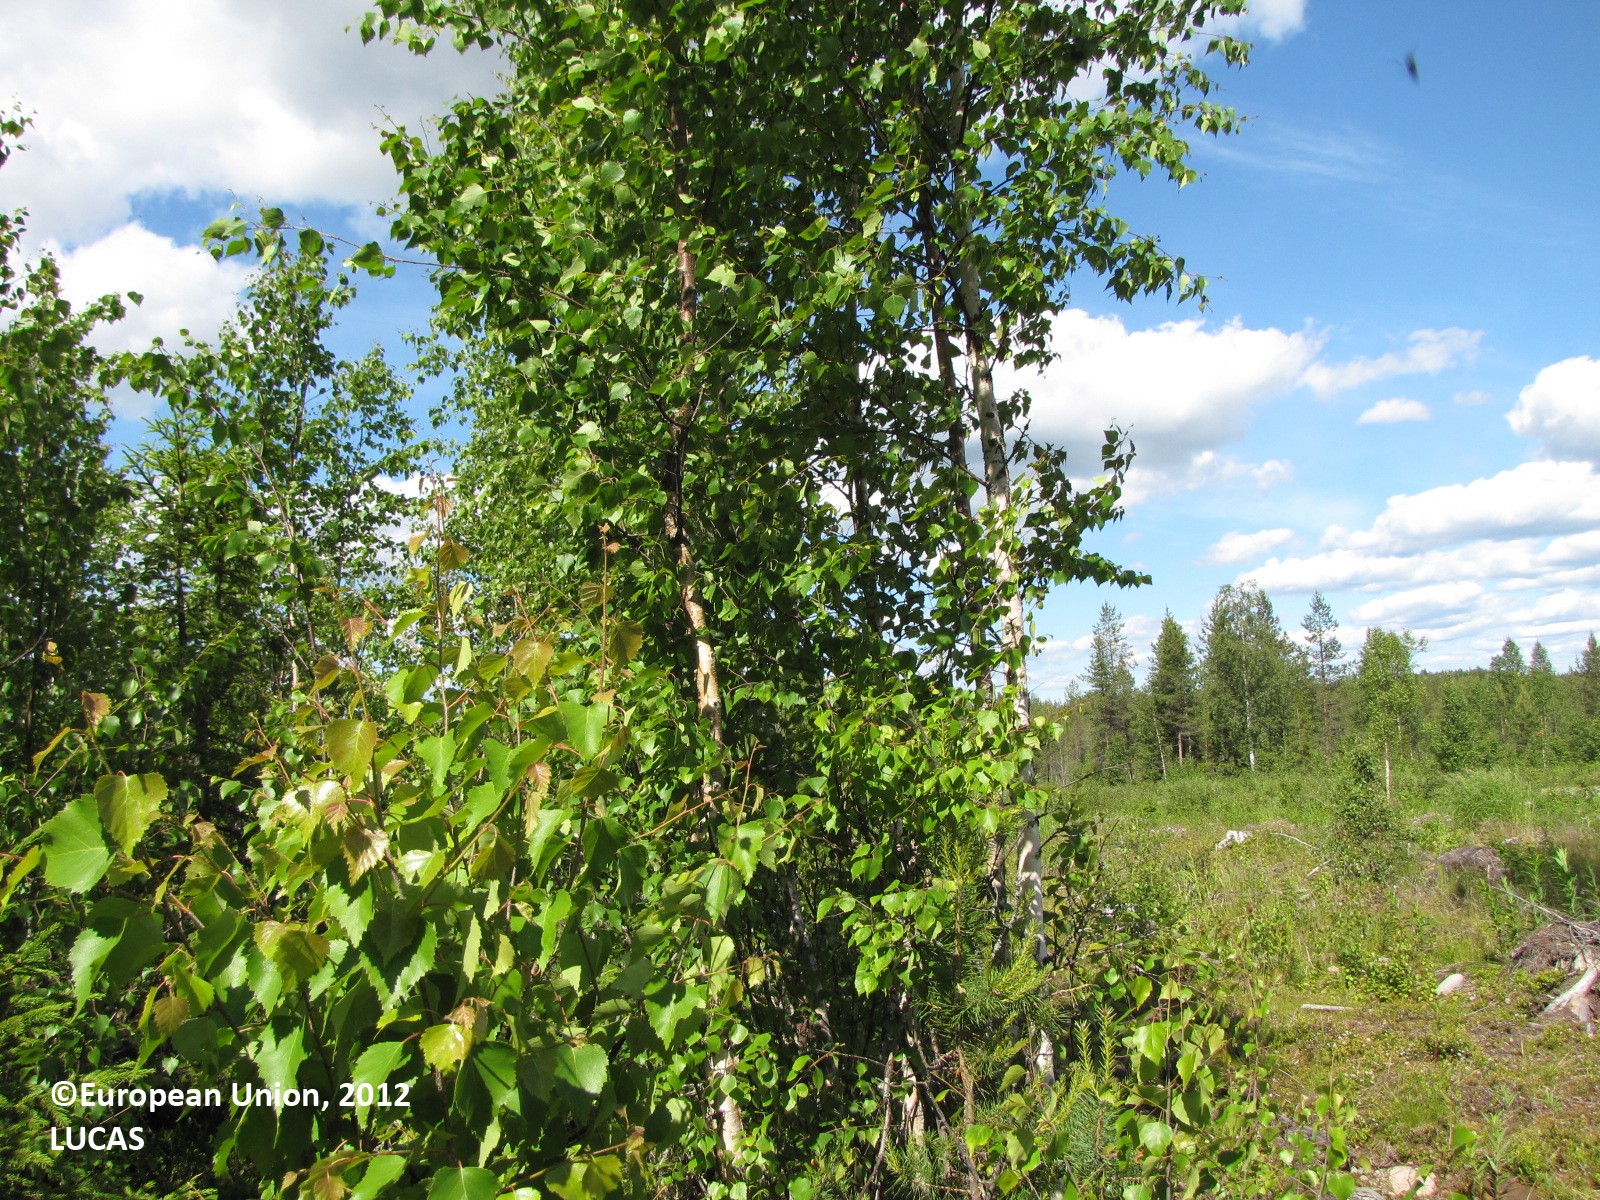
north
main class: Woodland
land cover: Broadleaved woodland
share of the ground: 50 - 75 %
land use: Forestry
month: July
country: FI
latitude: 66.1947
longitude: 25.1815
